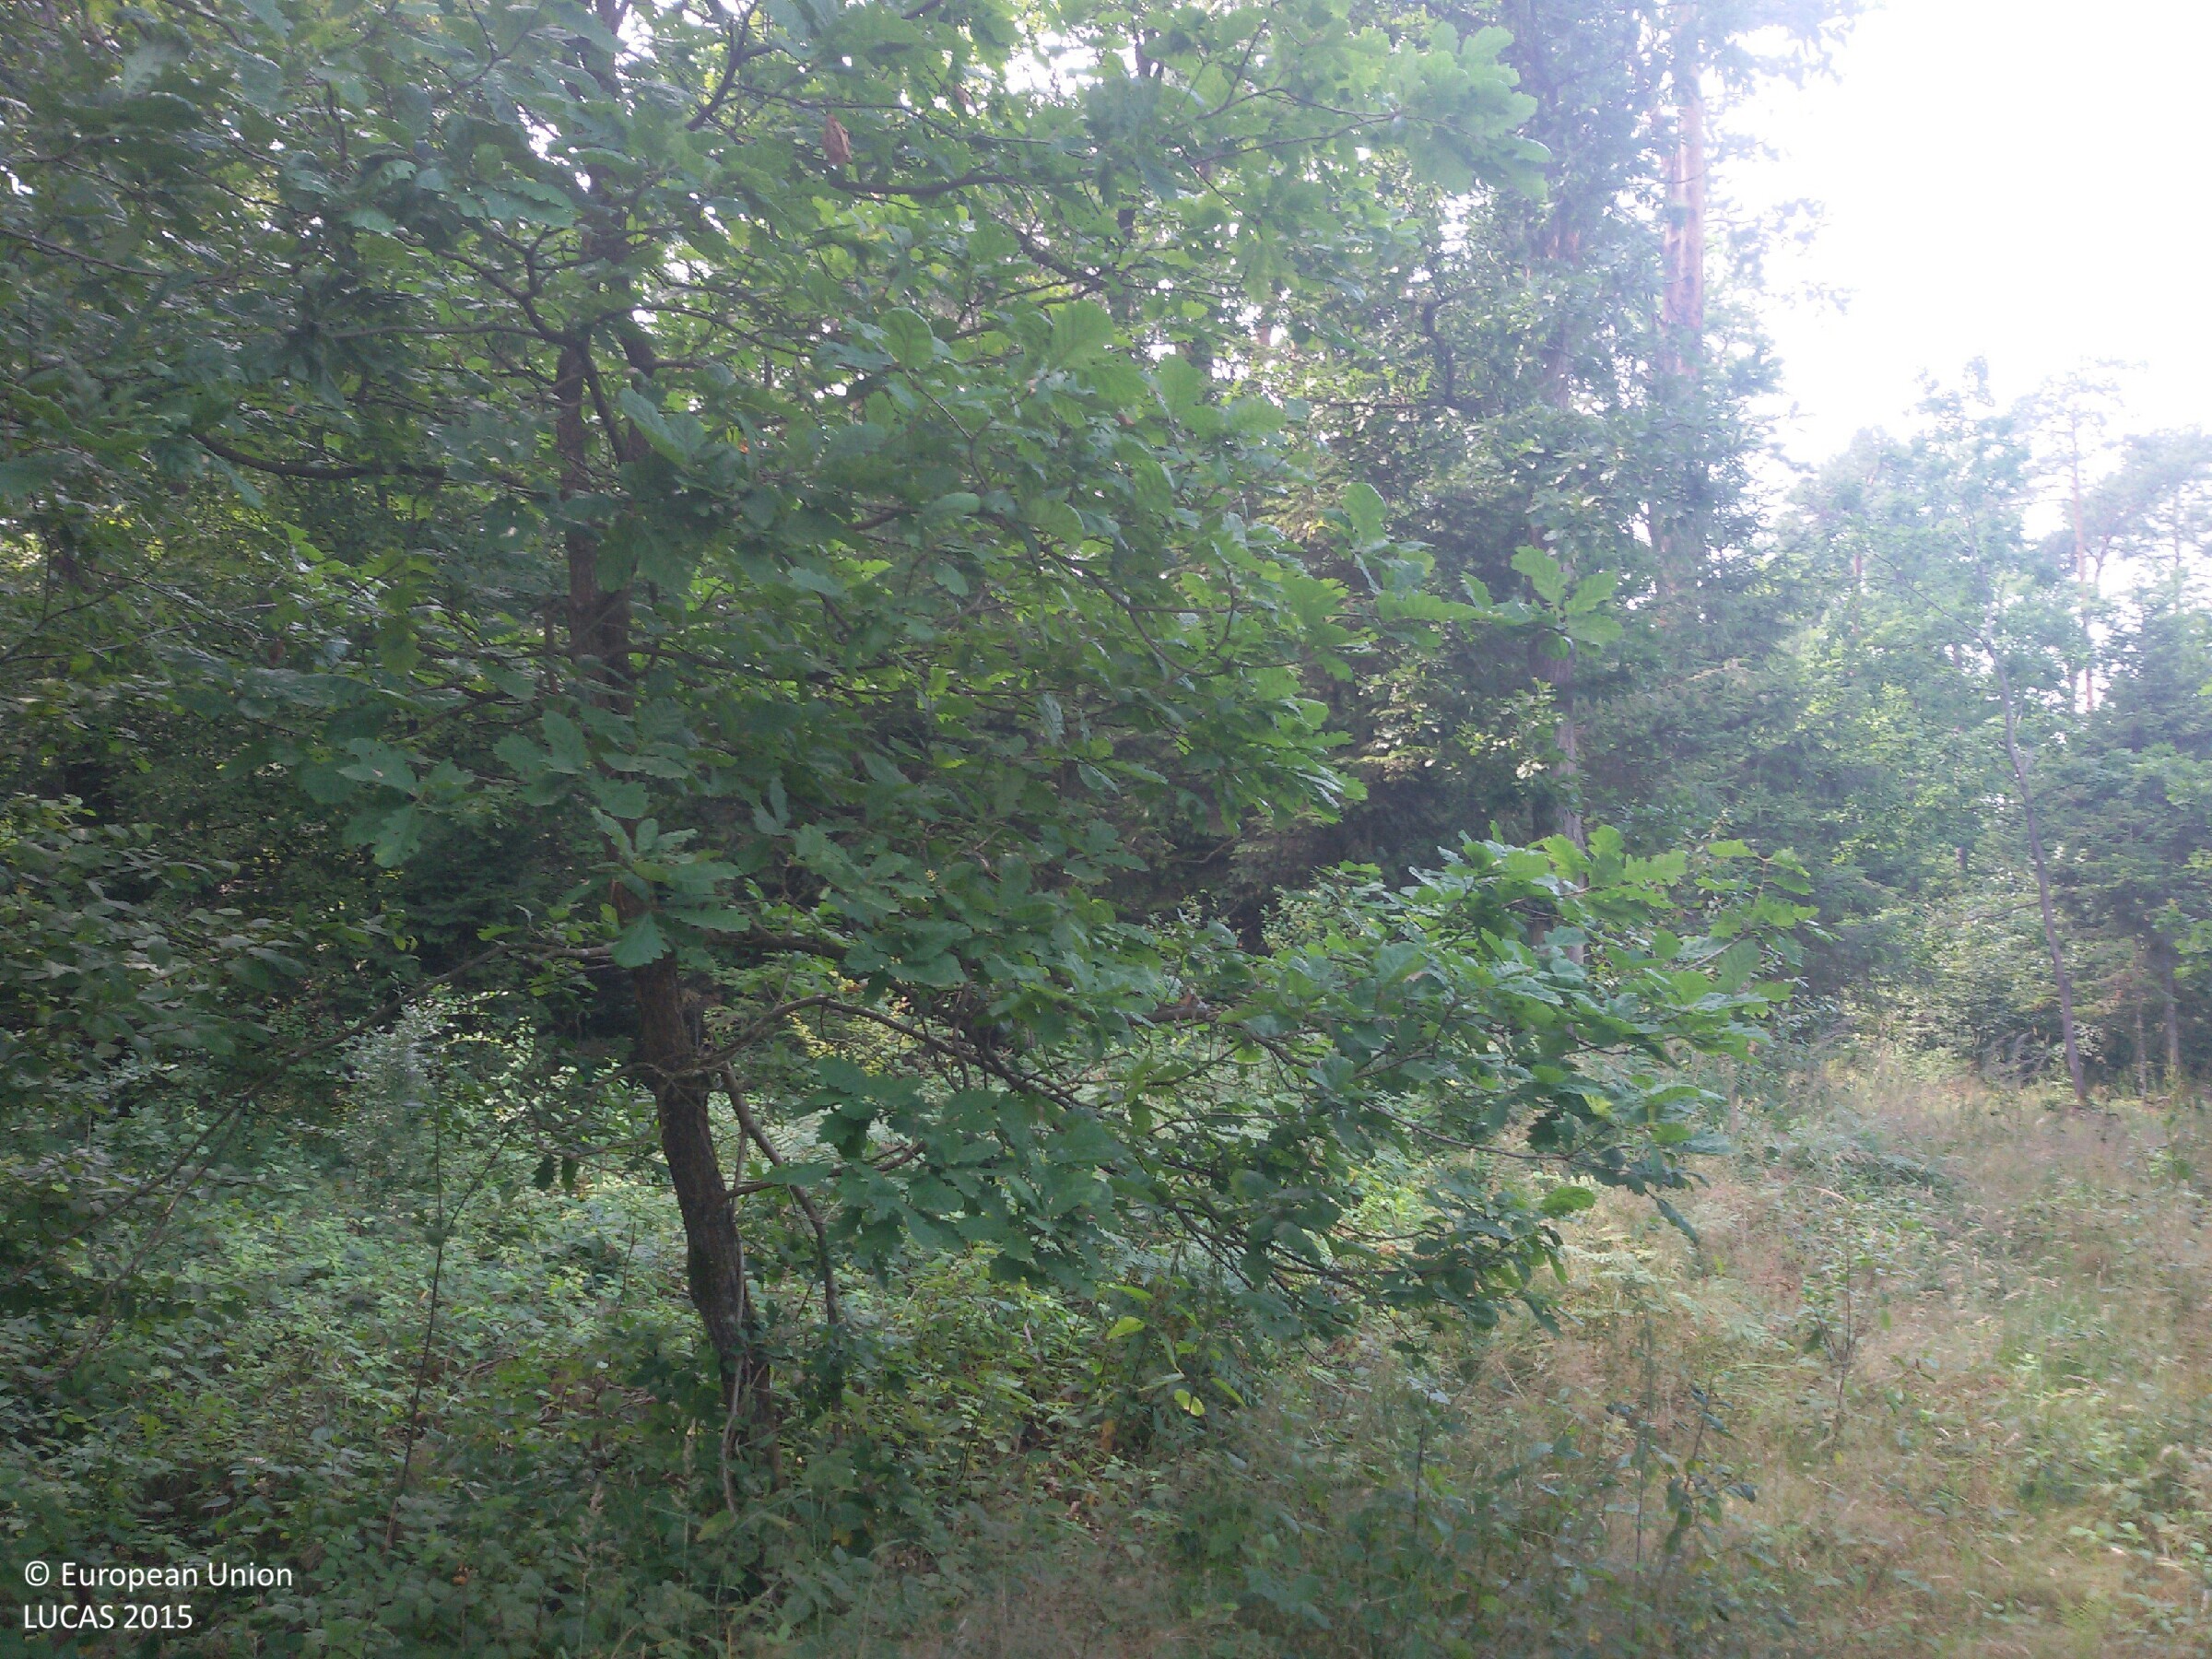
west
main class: Woodland
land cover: Pine dominated mixed woodland
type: hemiboreal forest and nemoral coniferous forest and mixed broadleaved-coniferous forest
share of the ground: > 75 %
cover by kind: coniferous forest trees 75 %, broadleaved forest trees 25 %
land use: Forestry
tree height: > 5 m
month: July
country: PL
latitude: 50.4706
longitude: 21.3341
